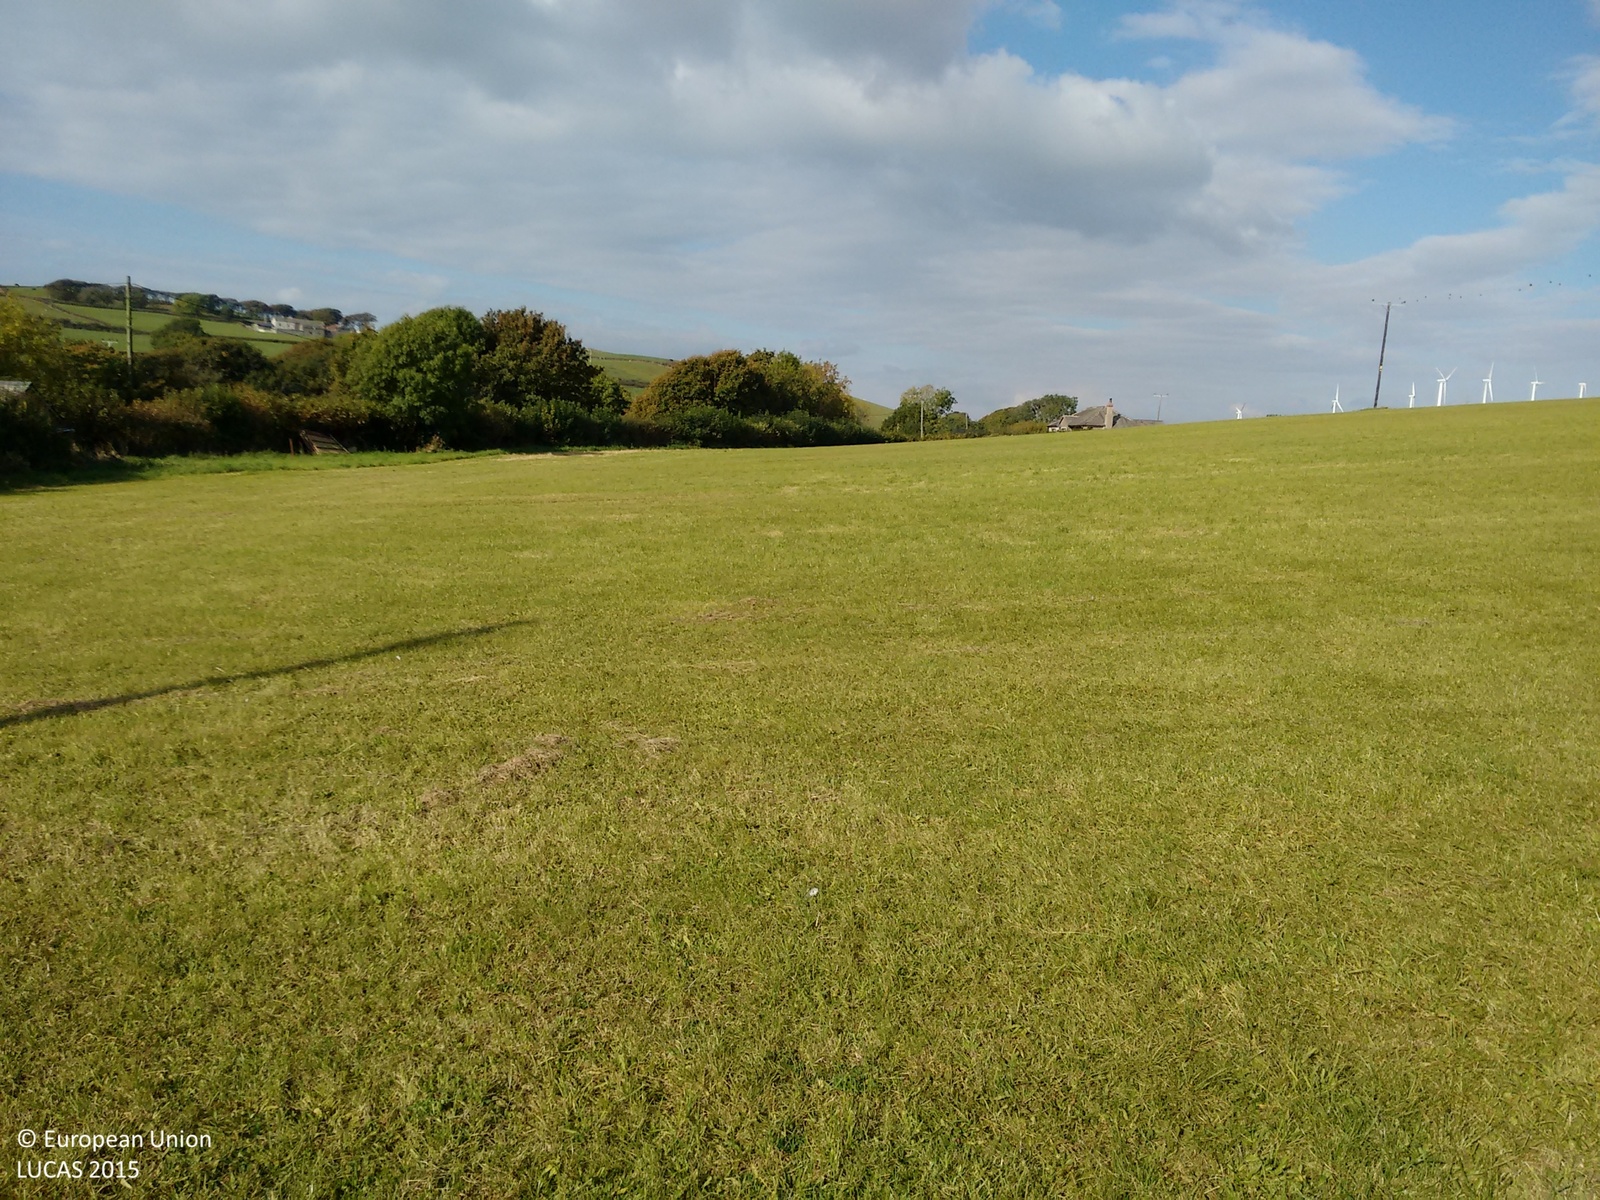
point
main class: Grassland
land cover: Grassland without tree/shrub cover
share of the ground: > 75 %
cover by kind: herbaceous plants 100 %
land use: Agriculture (excluding fallow land and kitchen gardens)
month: October
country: GB
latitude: 54.1731
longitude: -3.1743
